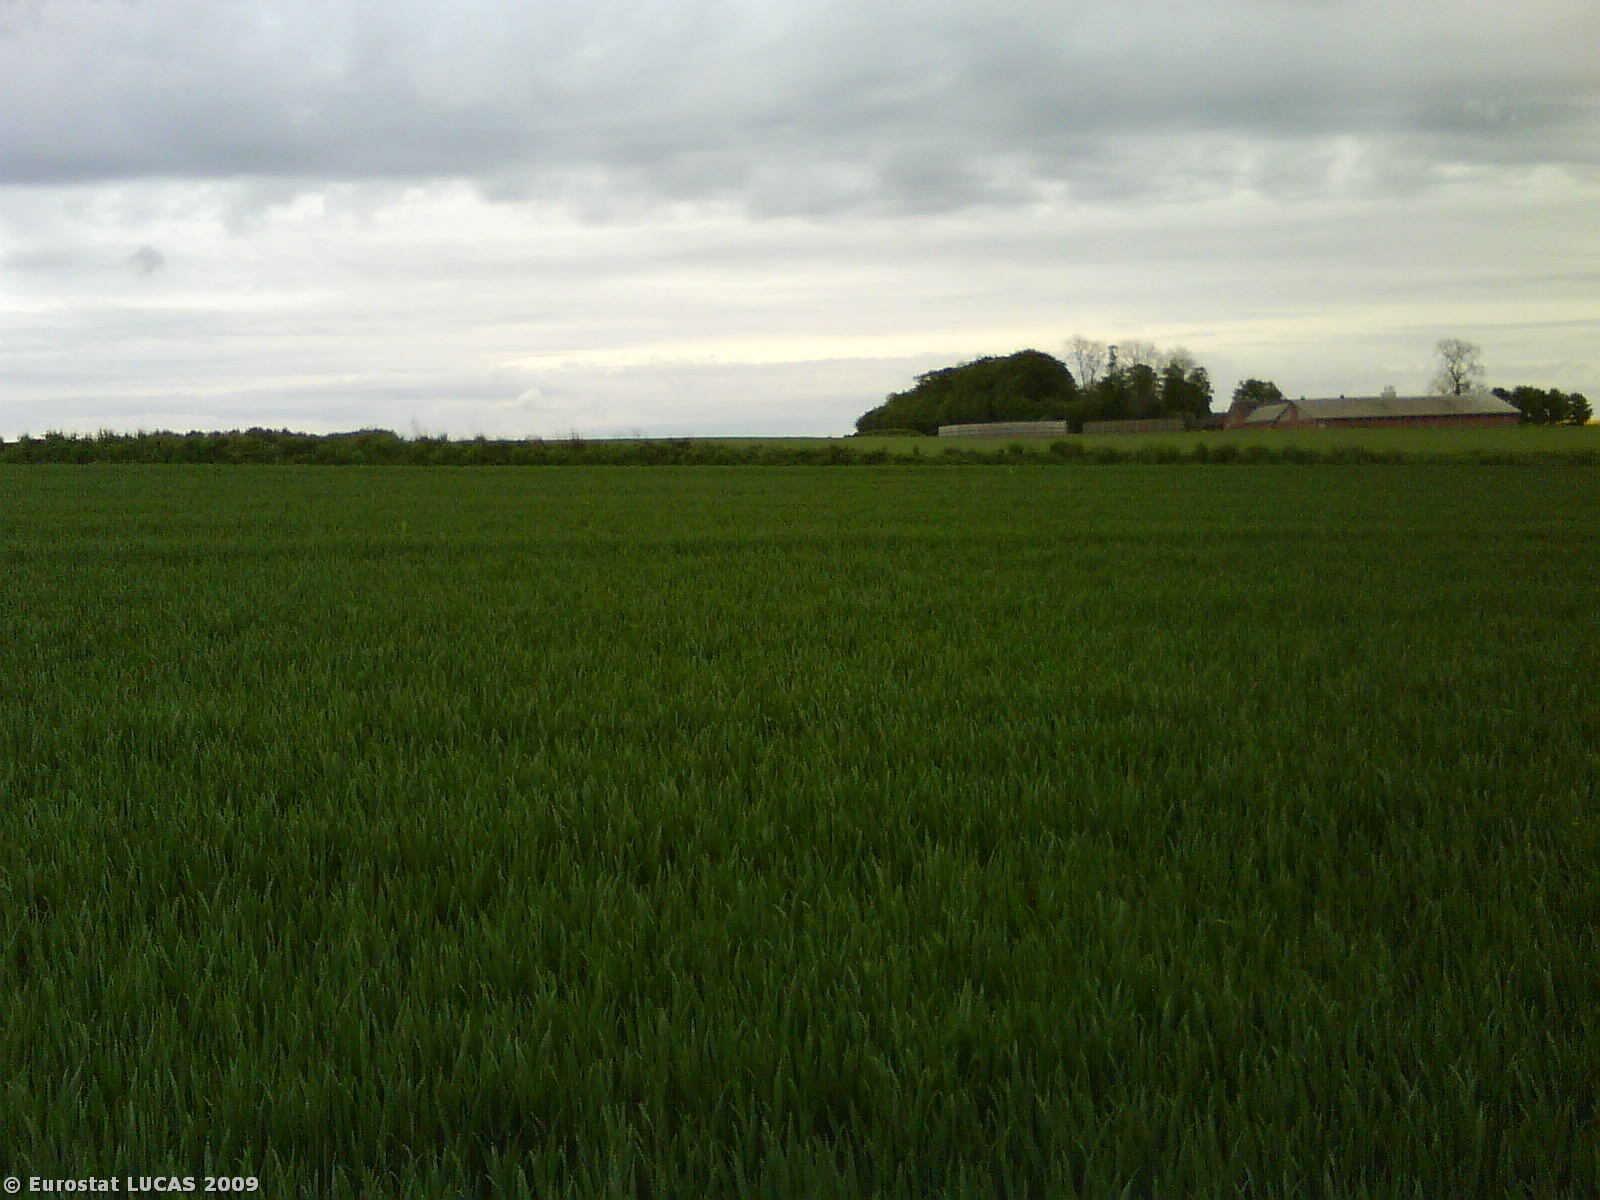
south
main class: Cropland
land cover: Common wheat
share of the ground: > 75 %
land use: Agriculture (excluding fallow land and kitchen gardens)
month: May
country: DK
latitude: 56.4212
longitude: 10.2429
